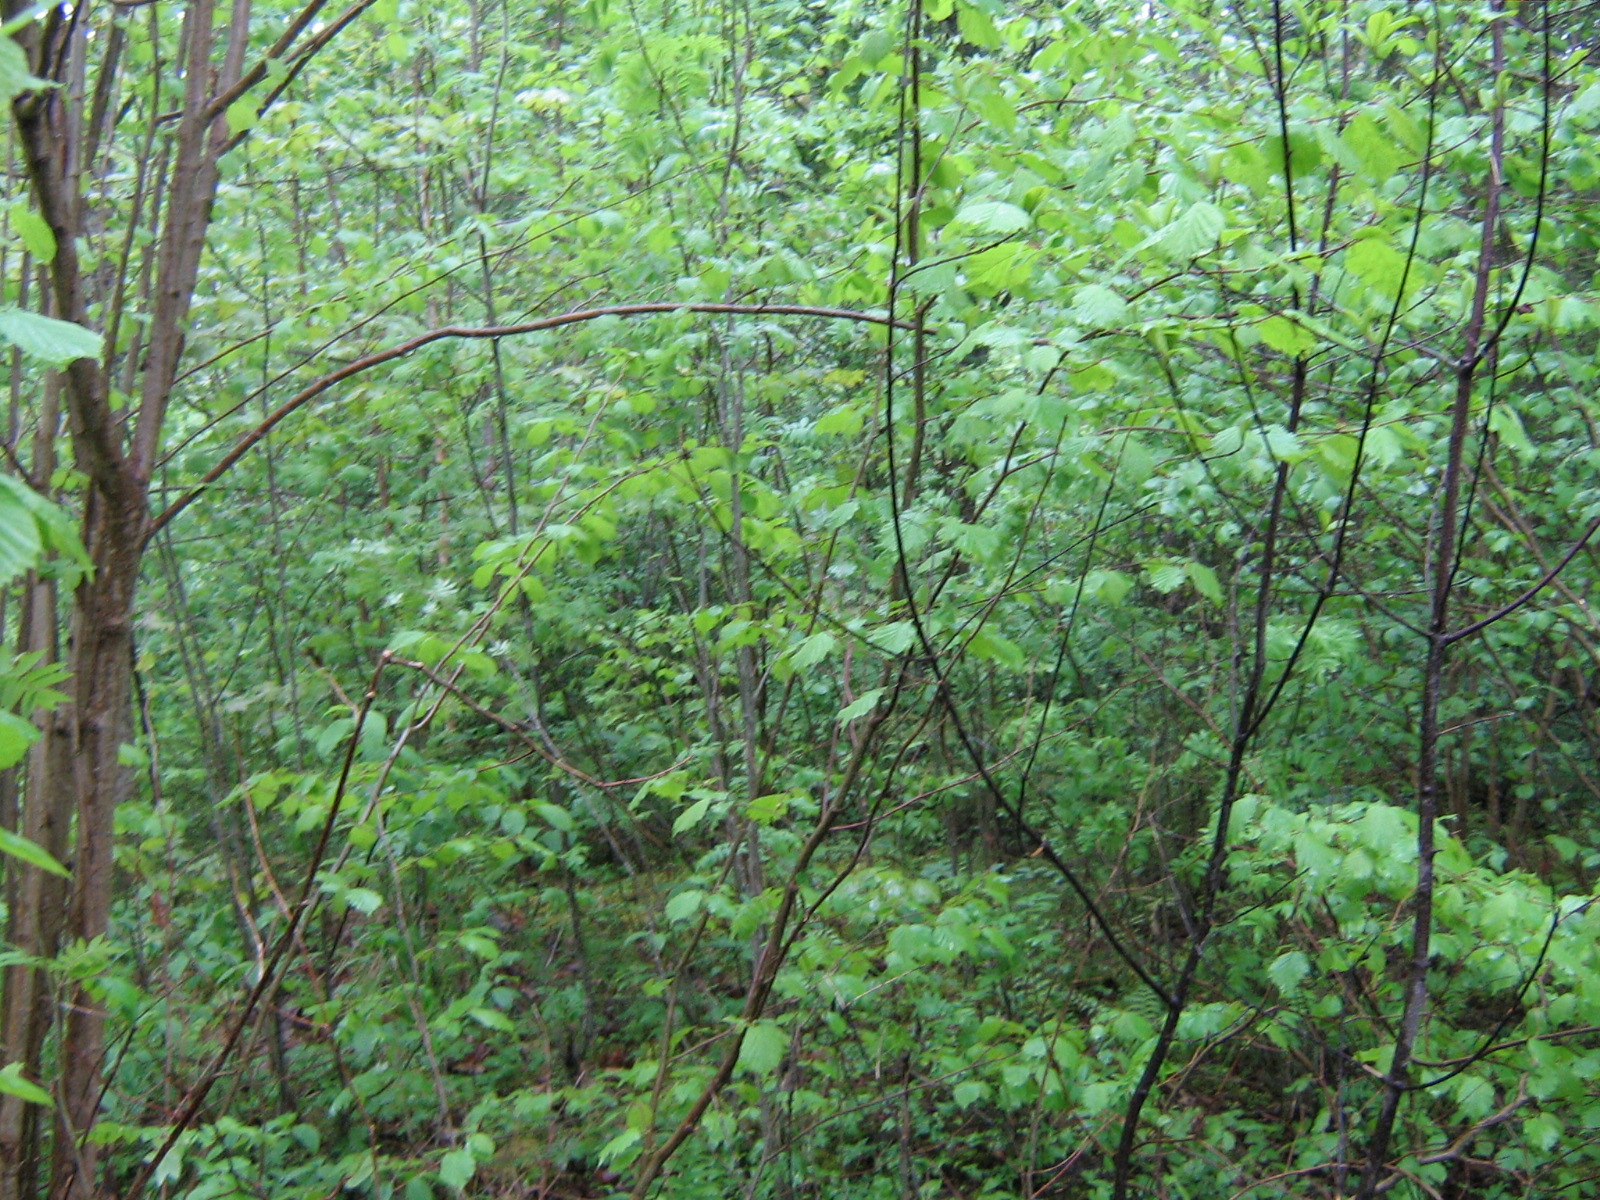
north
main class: Woodland
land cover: Broadleaved woodland
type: non-riverine alder, birch or aspen forest
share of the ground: > 75 %
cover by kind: broadleaved forest trees 100 %
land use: Semi-natural and natural areas not in use
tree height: > 5 m
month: May
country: LV
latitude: 57.3380
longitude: 25.8927
